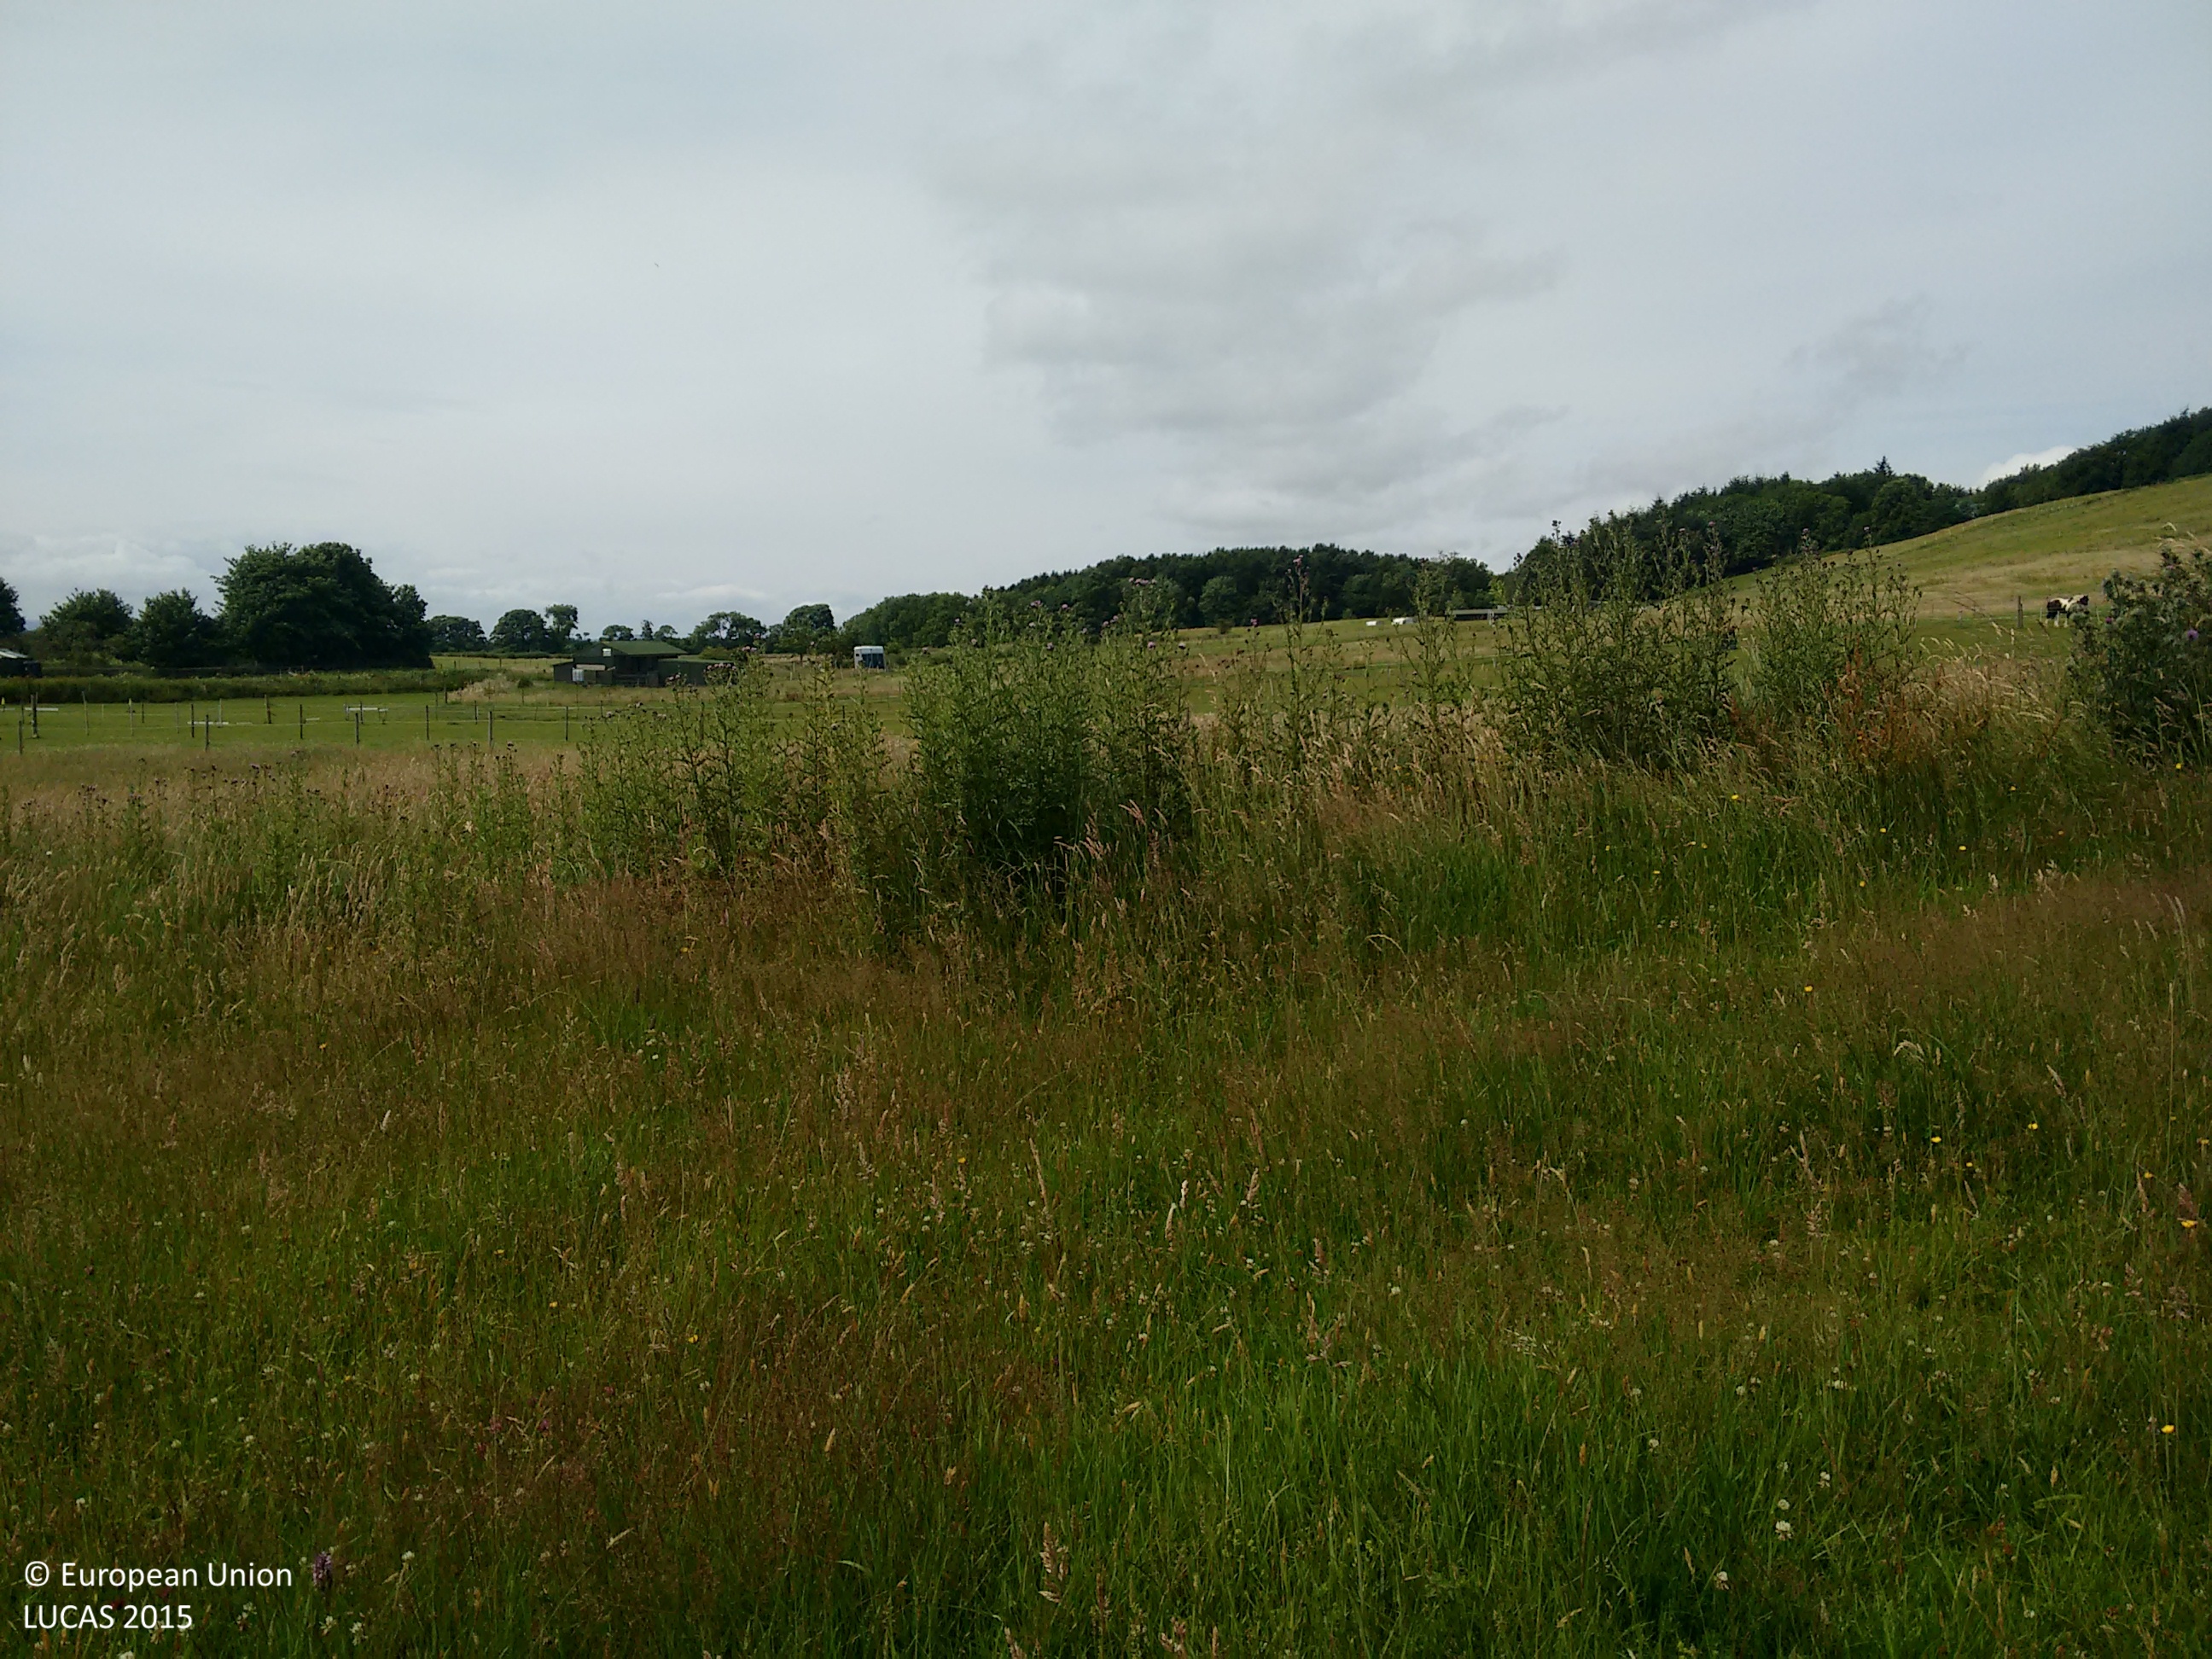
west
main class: Grassland
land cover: Grassland without tree/shrub cover
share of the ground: > 75 %
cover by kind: herbaceous plants 100 %
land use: Agriculture (excluding fallow land and kitchen gardens)
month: July
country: GB
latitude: 56.0516
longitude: -3.3526
